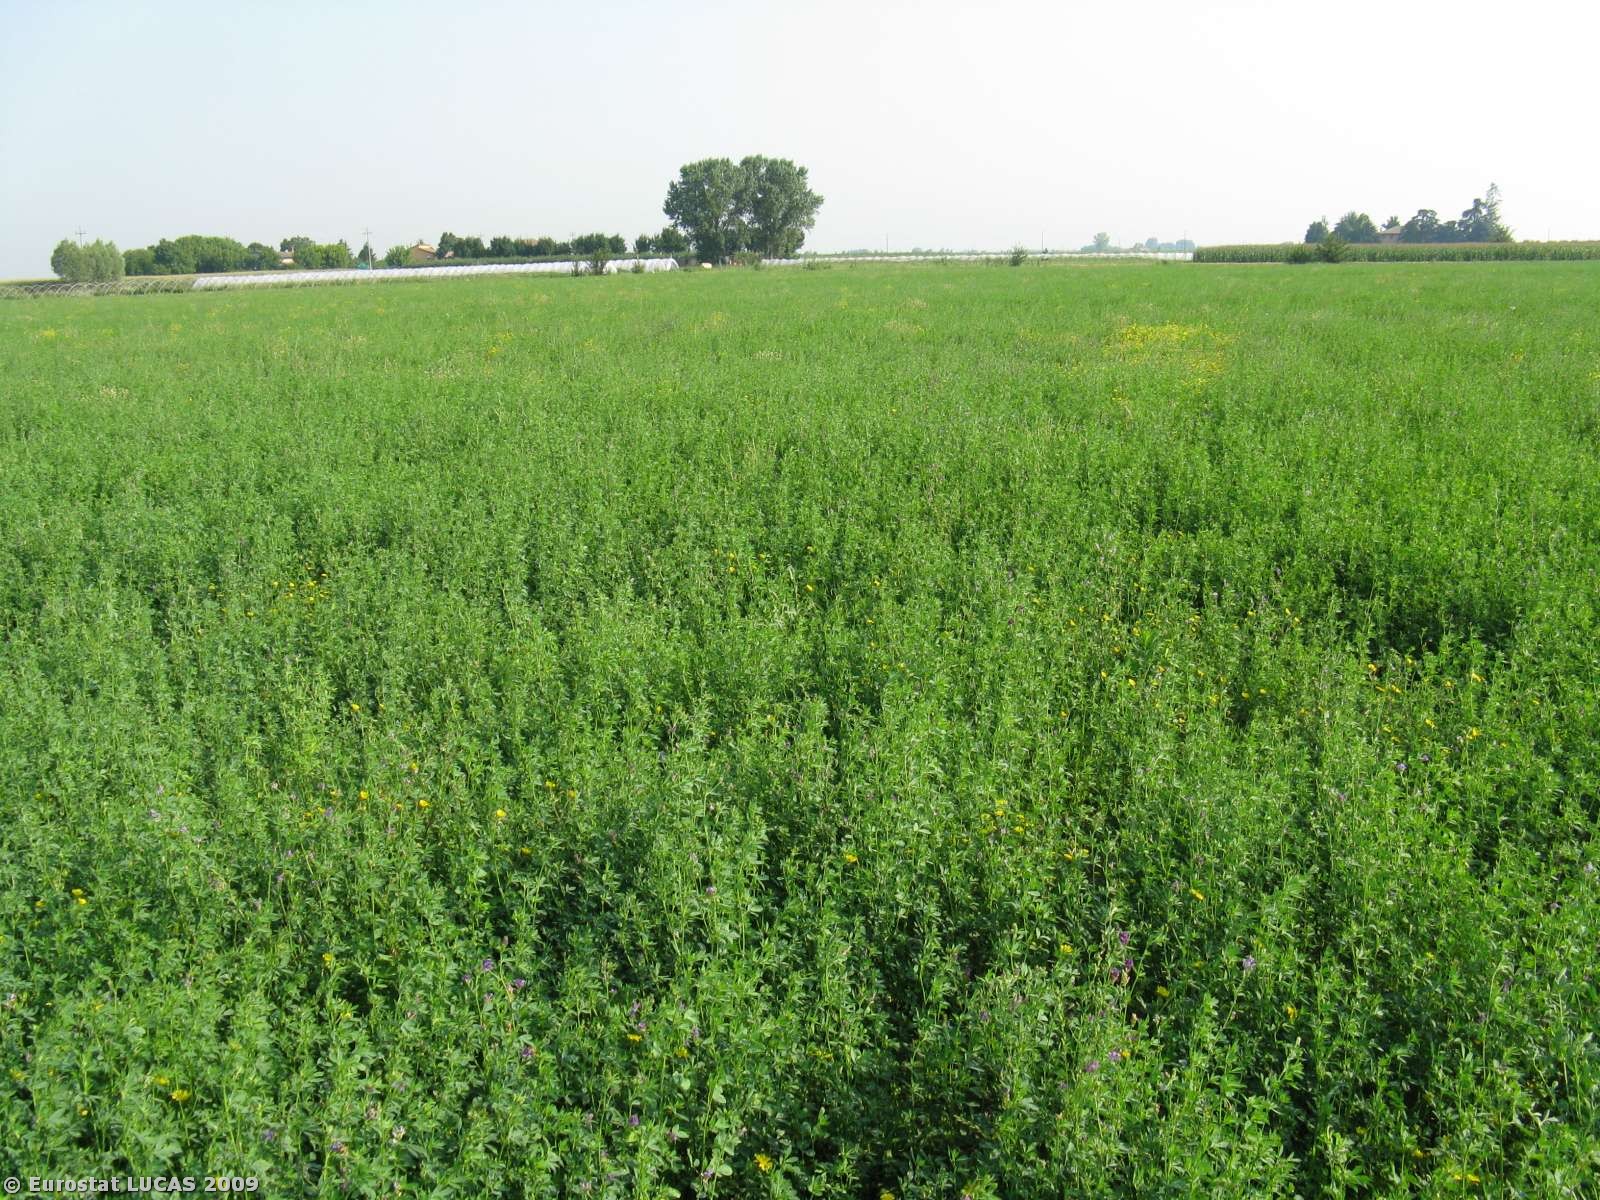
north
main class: Cropland
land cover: Lucerne
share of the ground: > 75 %
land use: Agriculture (excluding fallow land and kitchen gardens)
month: July
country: IT
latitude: 44.5900
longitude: 11.6467
